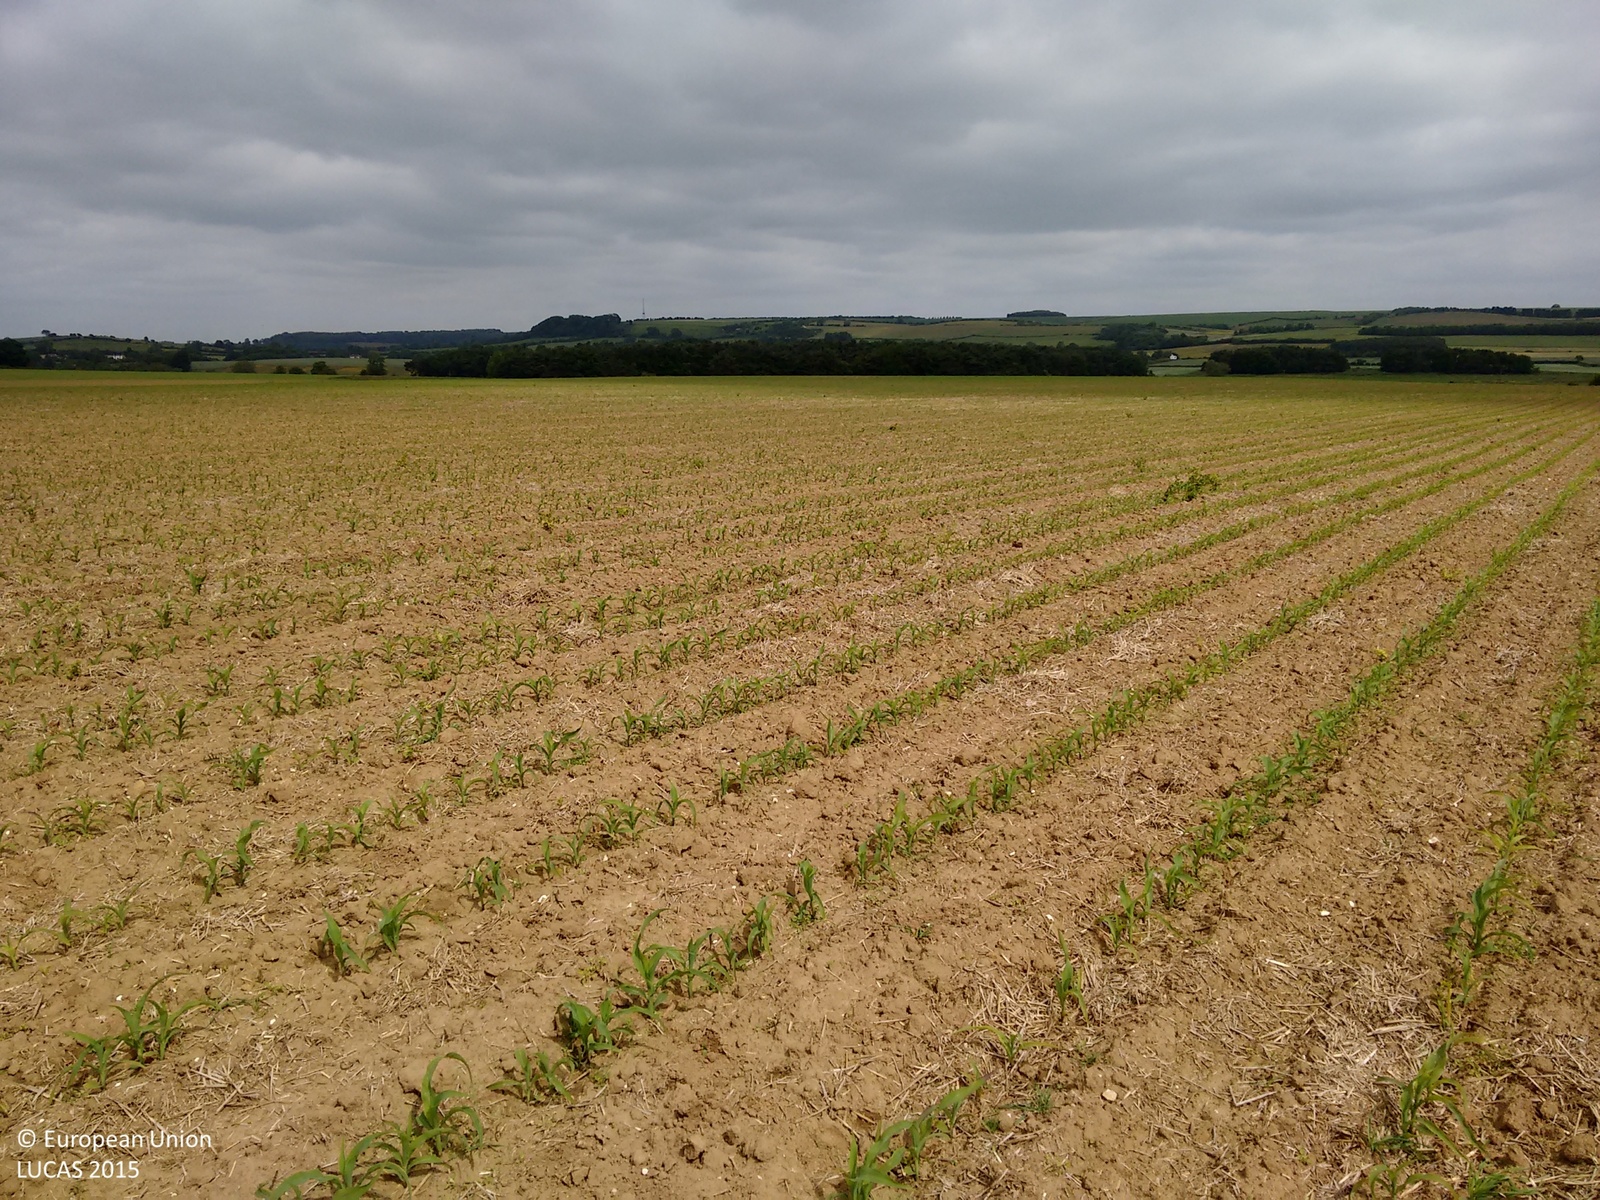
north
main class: Cropland
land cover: Maize
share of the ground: 50 - 75 %
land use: Agriculture (excluding fallow land and kitchen gardens)
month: June
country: GB
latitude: 53.2869
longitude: -0.0982
